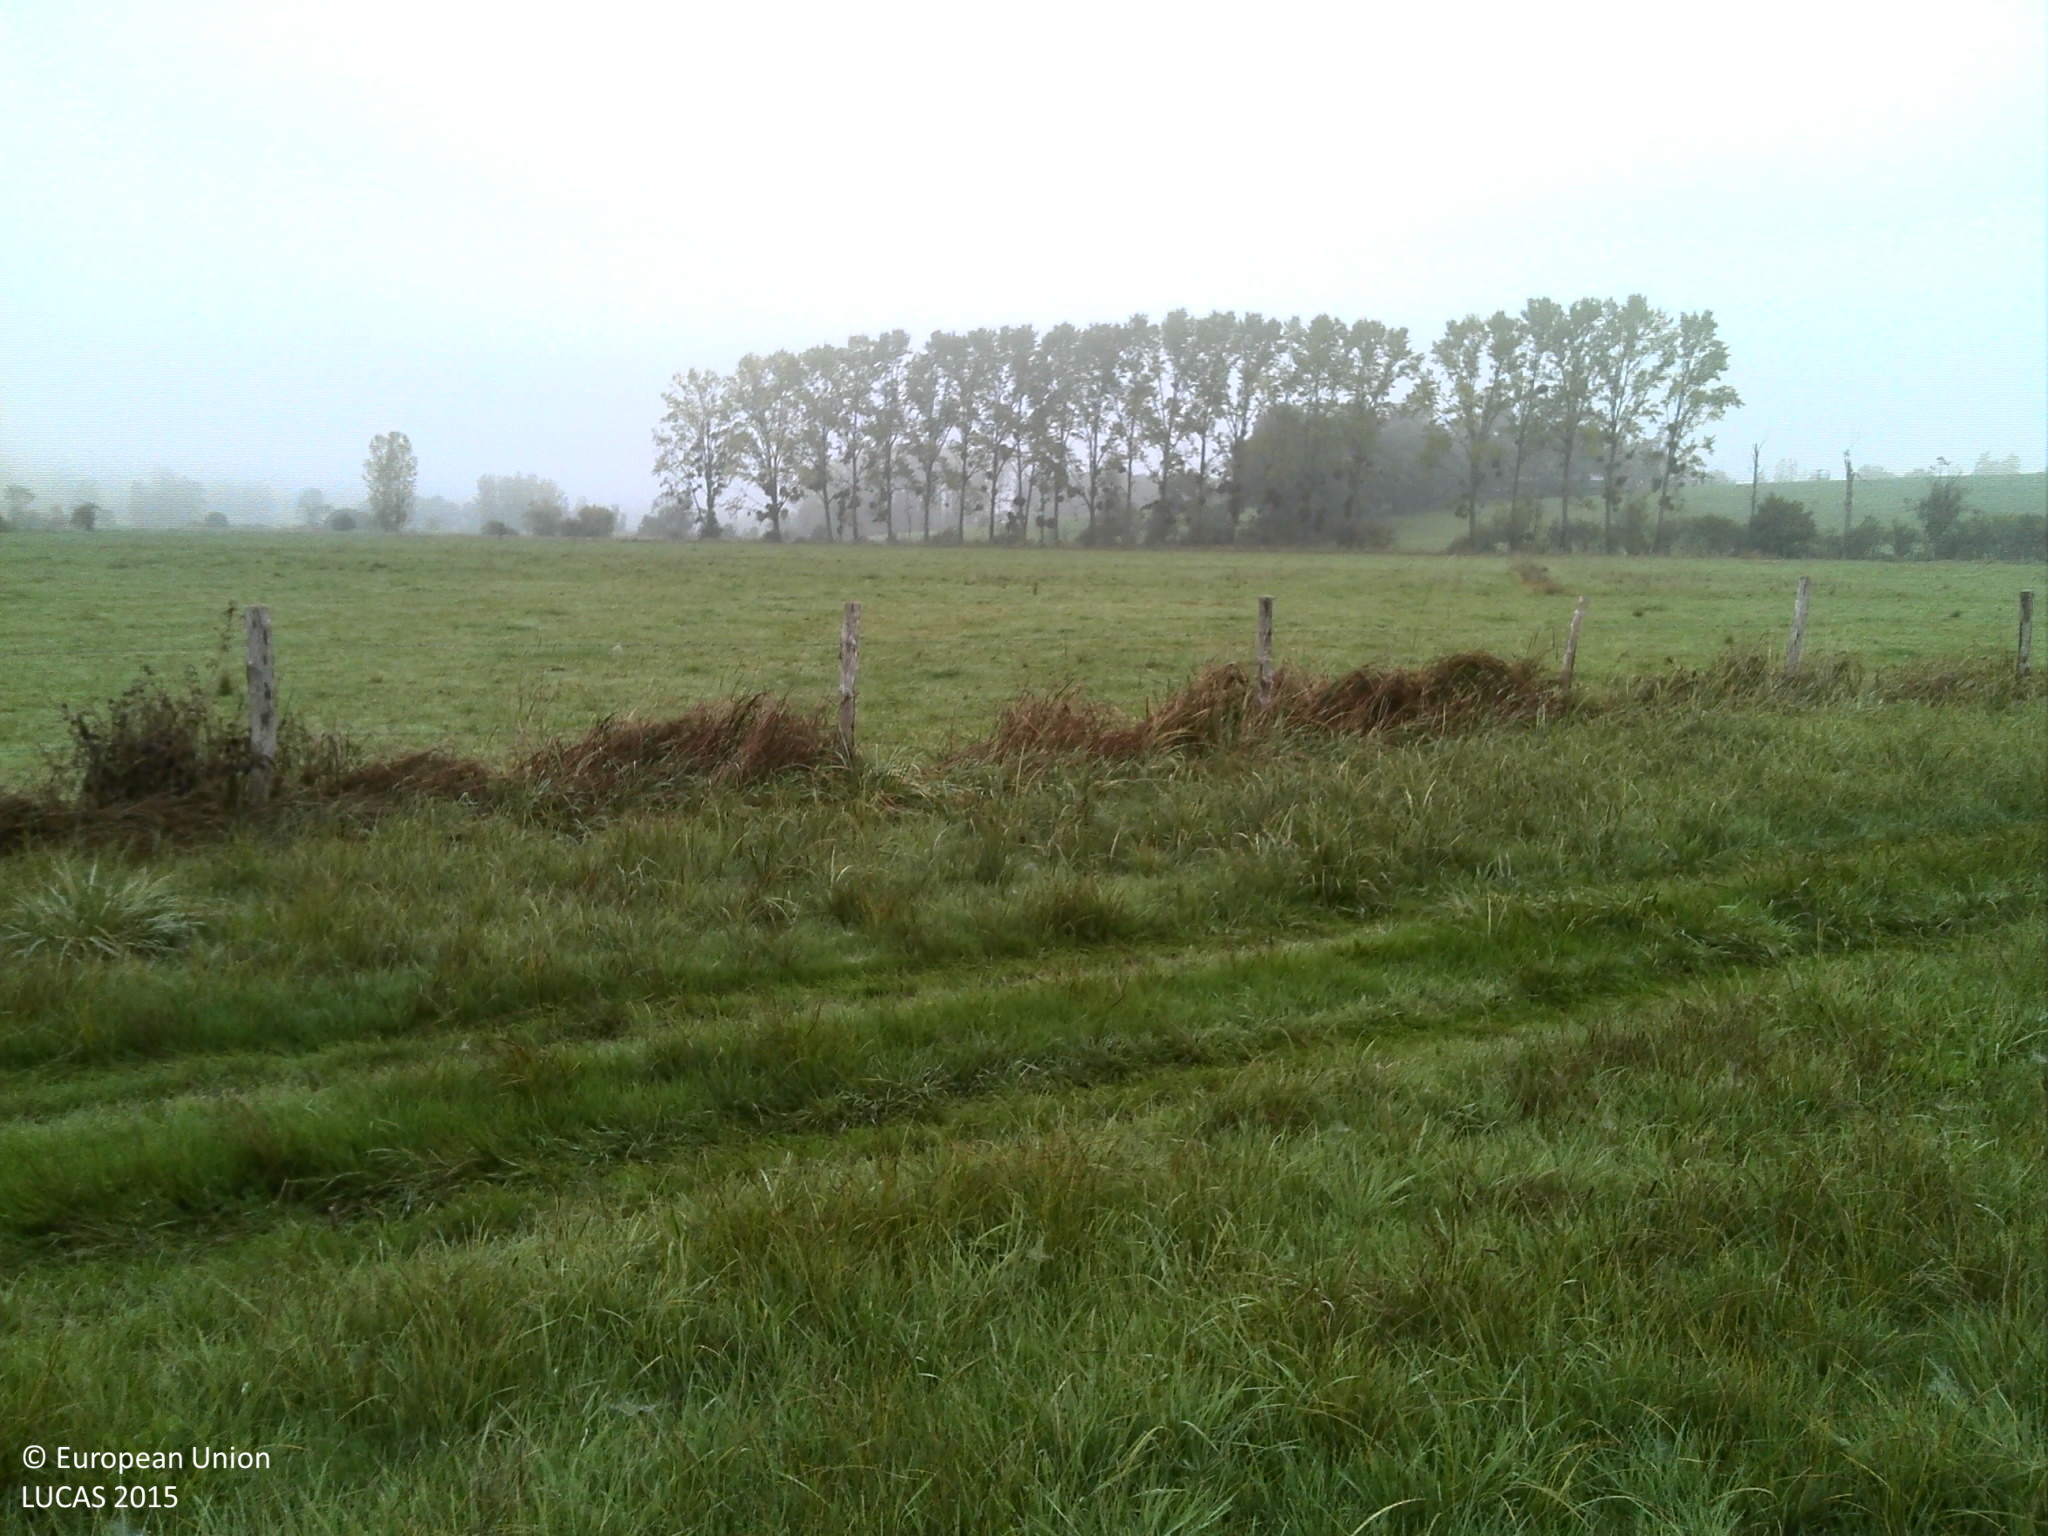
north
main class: Grassland
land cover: Grassland without tree/shrub cover
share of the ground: > 75 %
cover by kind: herbaceous plants 100 %
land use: Road transport
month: October
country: FR
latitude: 46.4454
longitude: 5.2773
